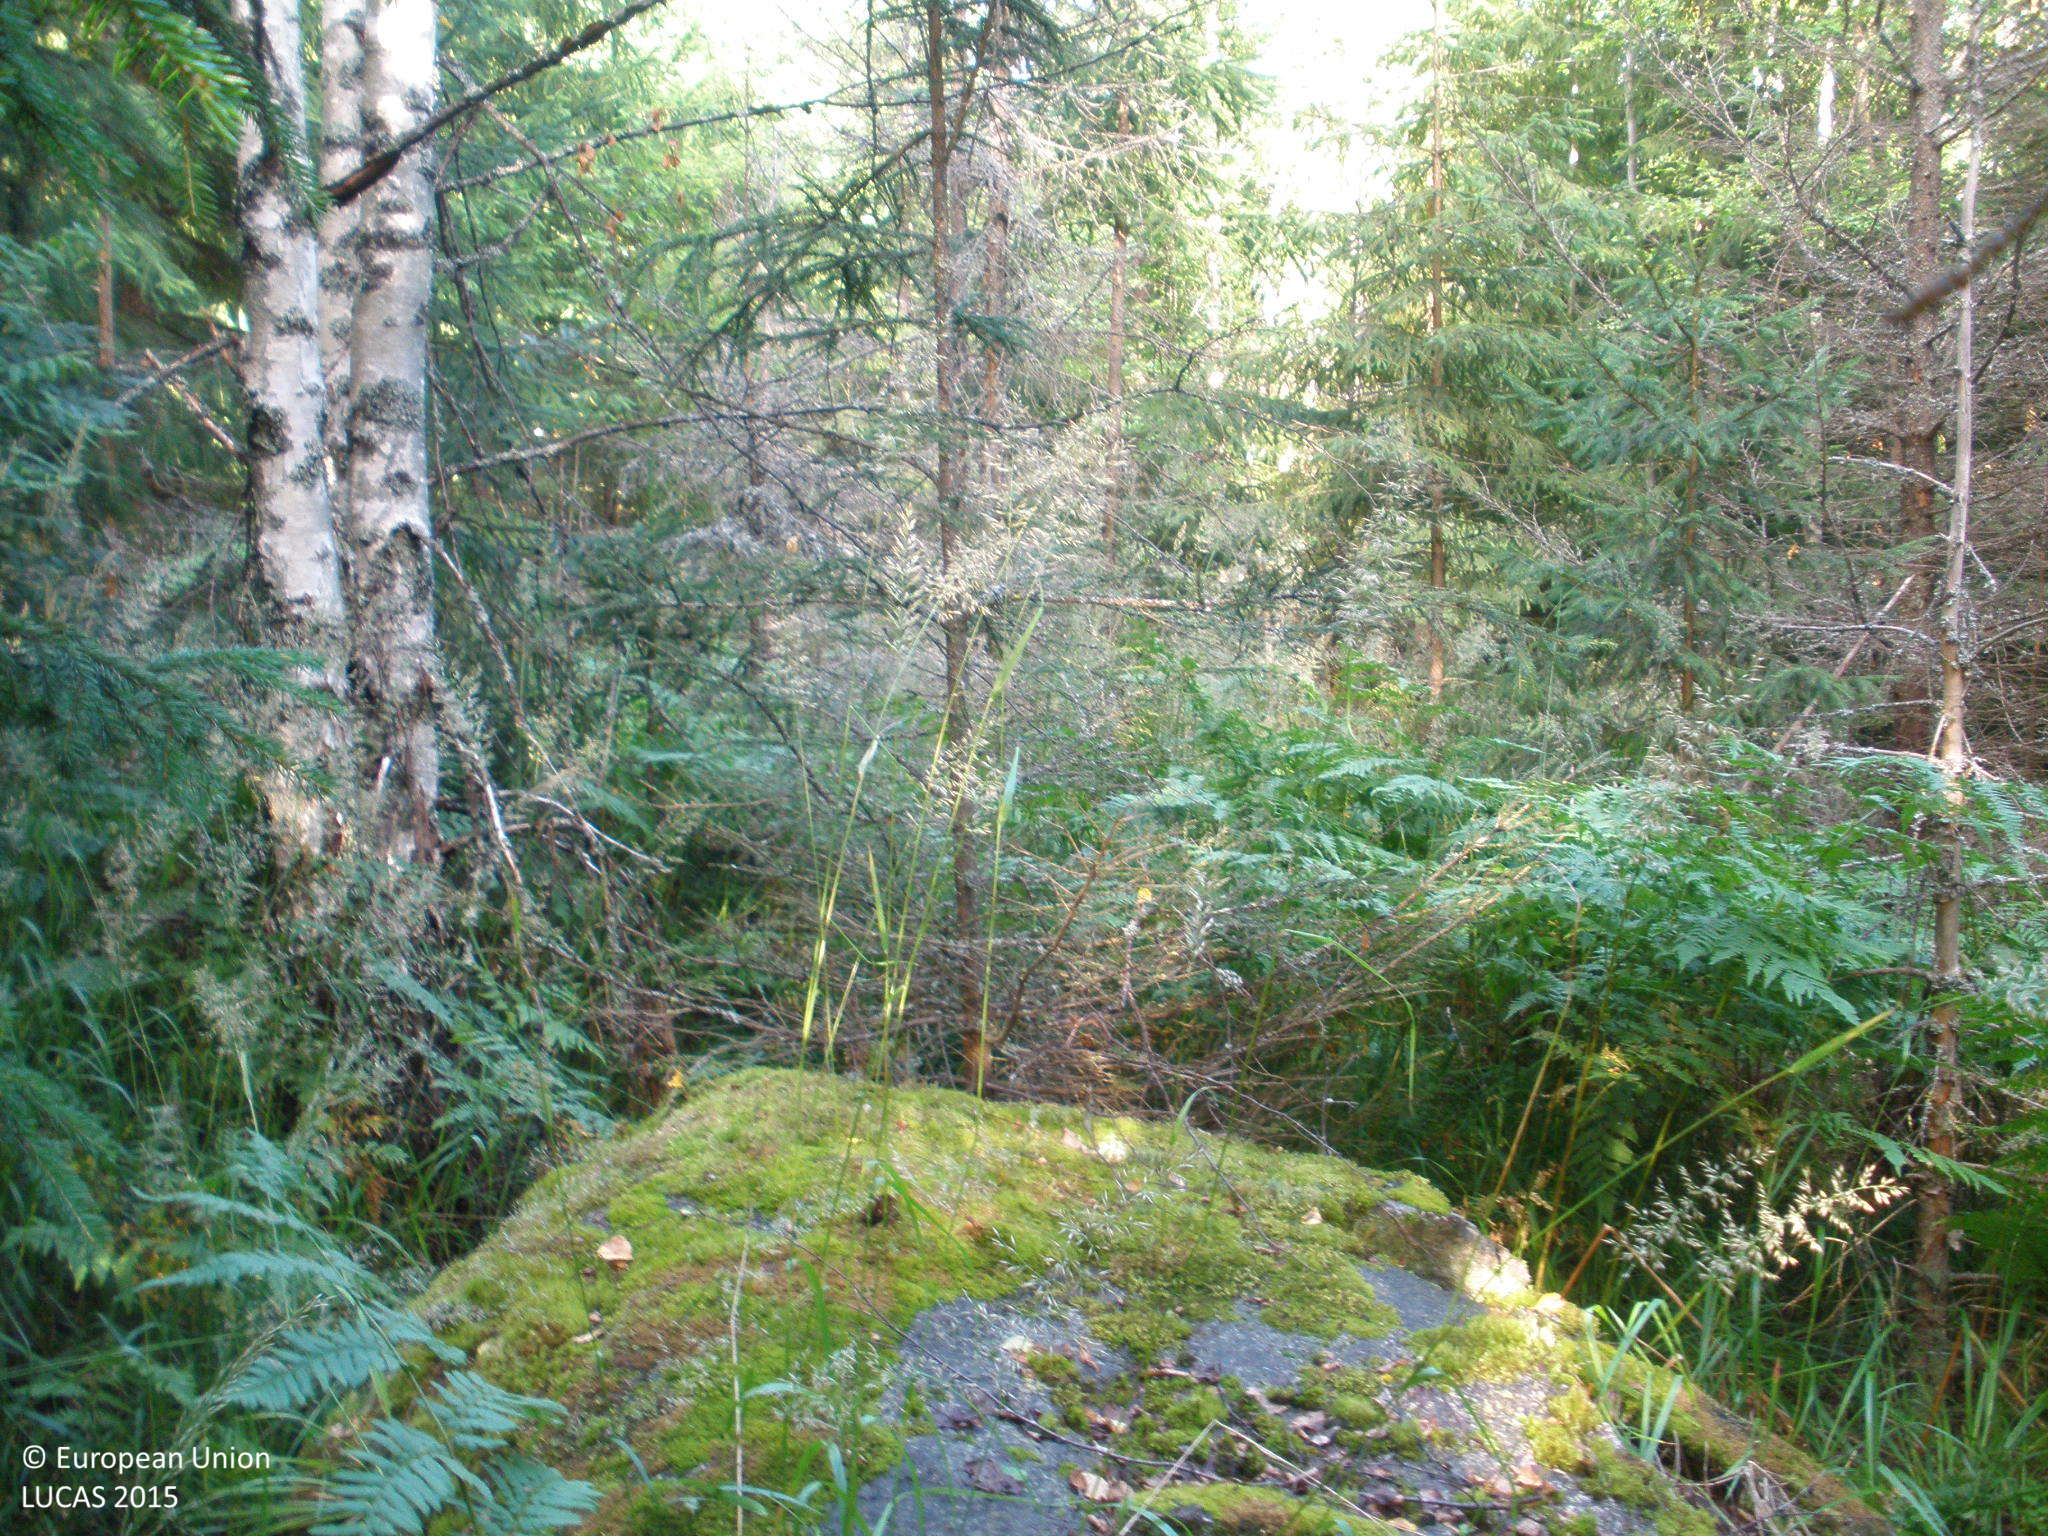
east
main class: Woodland
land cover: Spruce dominated mixed woodland
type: boreal forest
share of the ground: > 75 %
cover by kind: coniferous forest trees 60 %, broadleaved forest trees 25 %, herbaceous plants 10 %, lichens and mosses 5 %
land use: Forestry
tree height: > 5 m
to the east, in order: Spruce dominated mixed woodland; Spruce dominated coniferous woodland; Spruce dominated mixed woodland; Spruce dominated coniferous woodland; Spruce dominated mixed woodland; Spruce dominated coniferous woodland
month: August
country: FI
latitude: 60.7050
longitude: 24.3744
